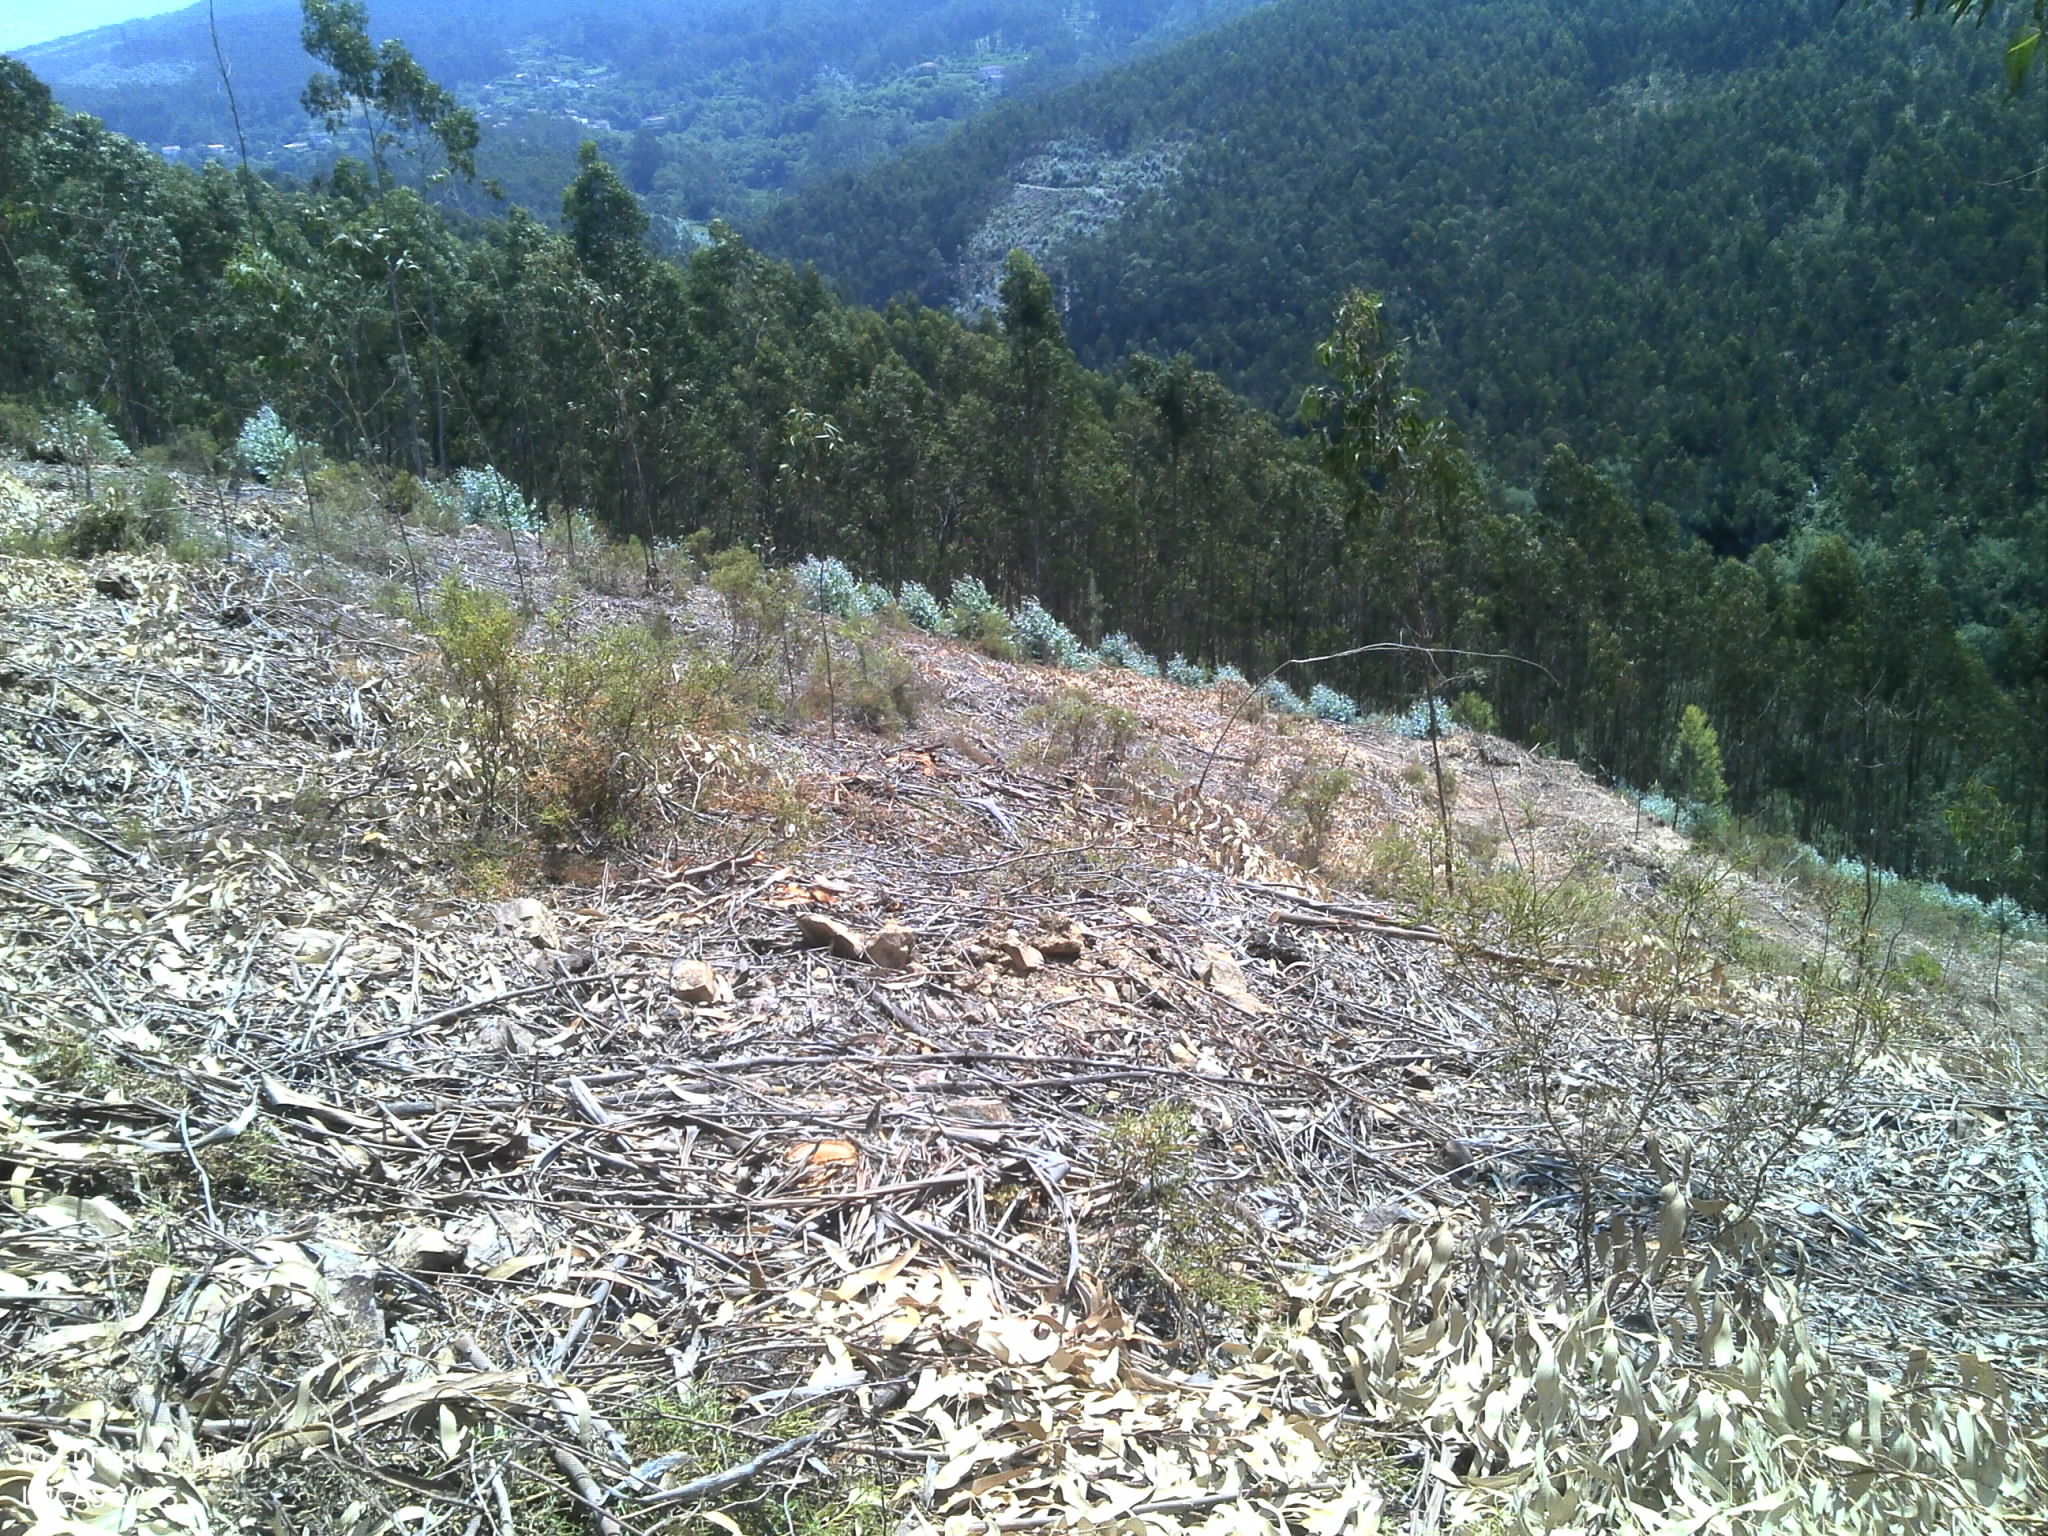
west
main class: Woodland
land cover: Broadleaved woodland
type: exotic forest
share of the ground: 50 - 75 %
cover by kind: broadleaved forest trees 70 %, shrubs 25 %, unconsolidated bare surface 5 %
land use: Forestry
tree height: > 5 m
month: July
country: PT
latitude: 40.6270
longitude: -8.3539
